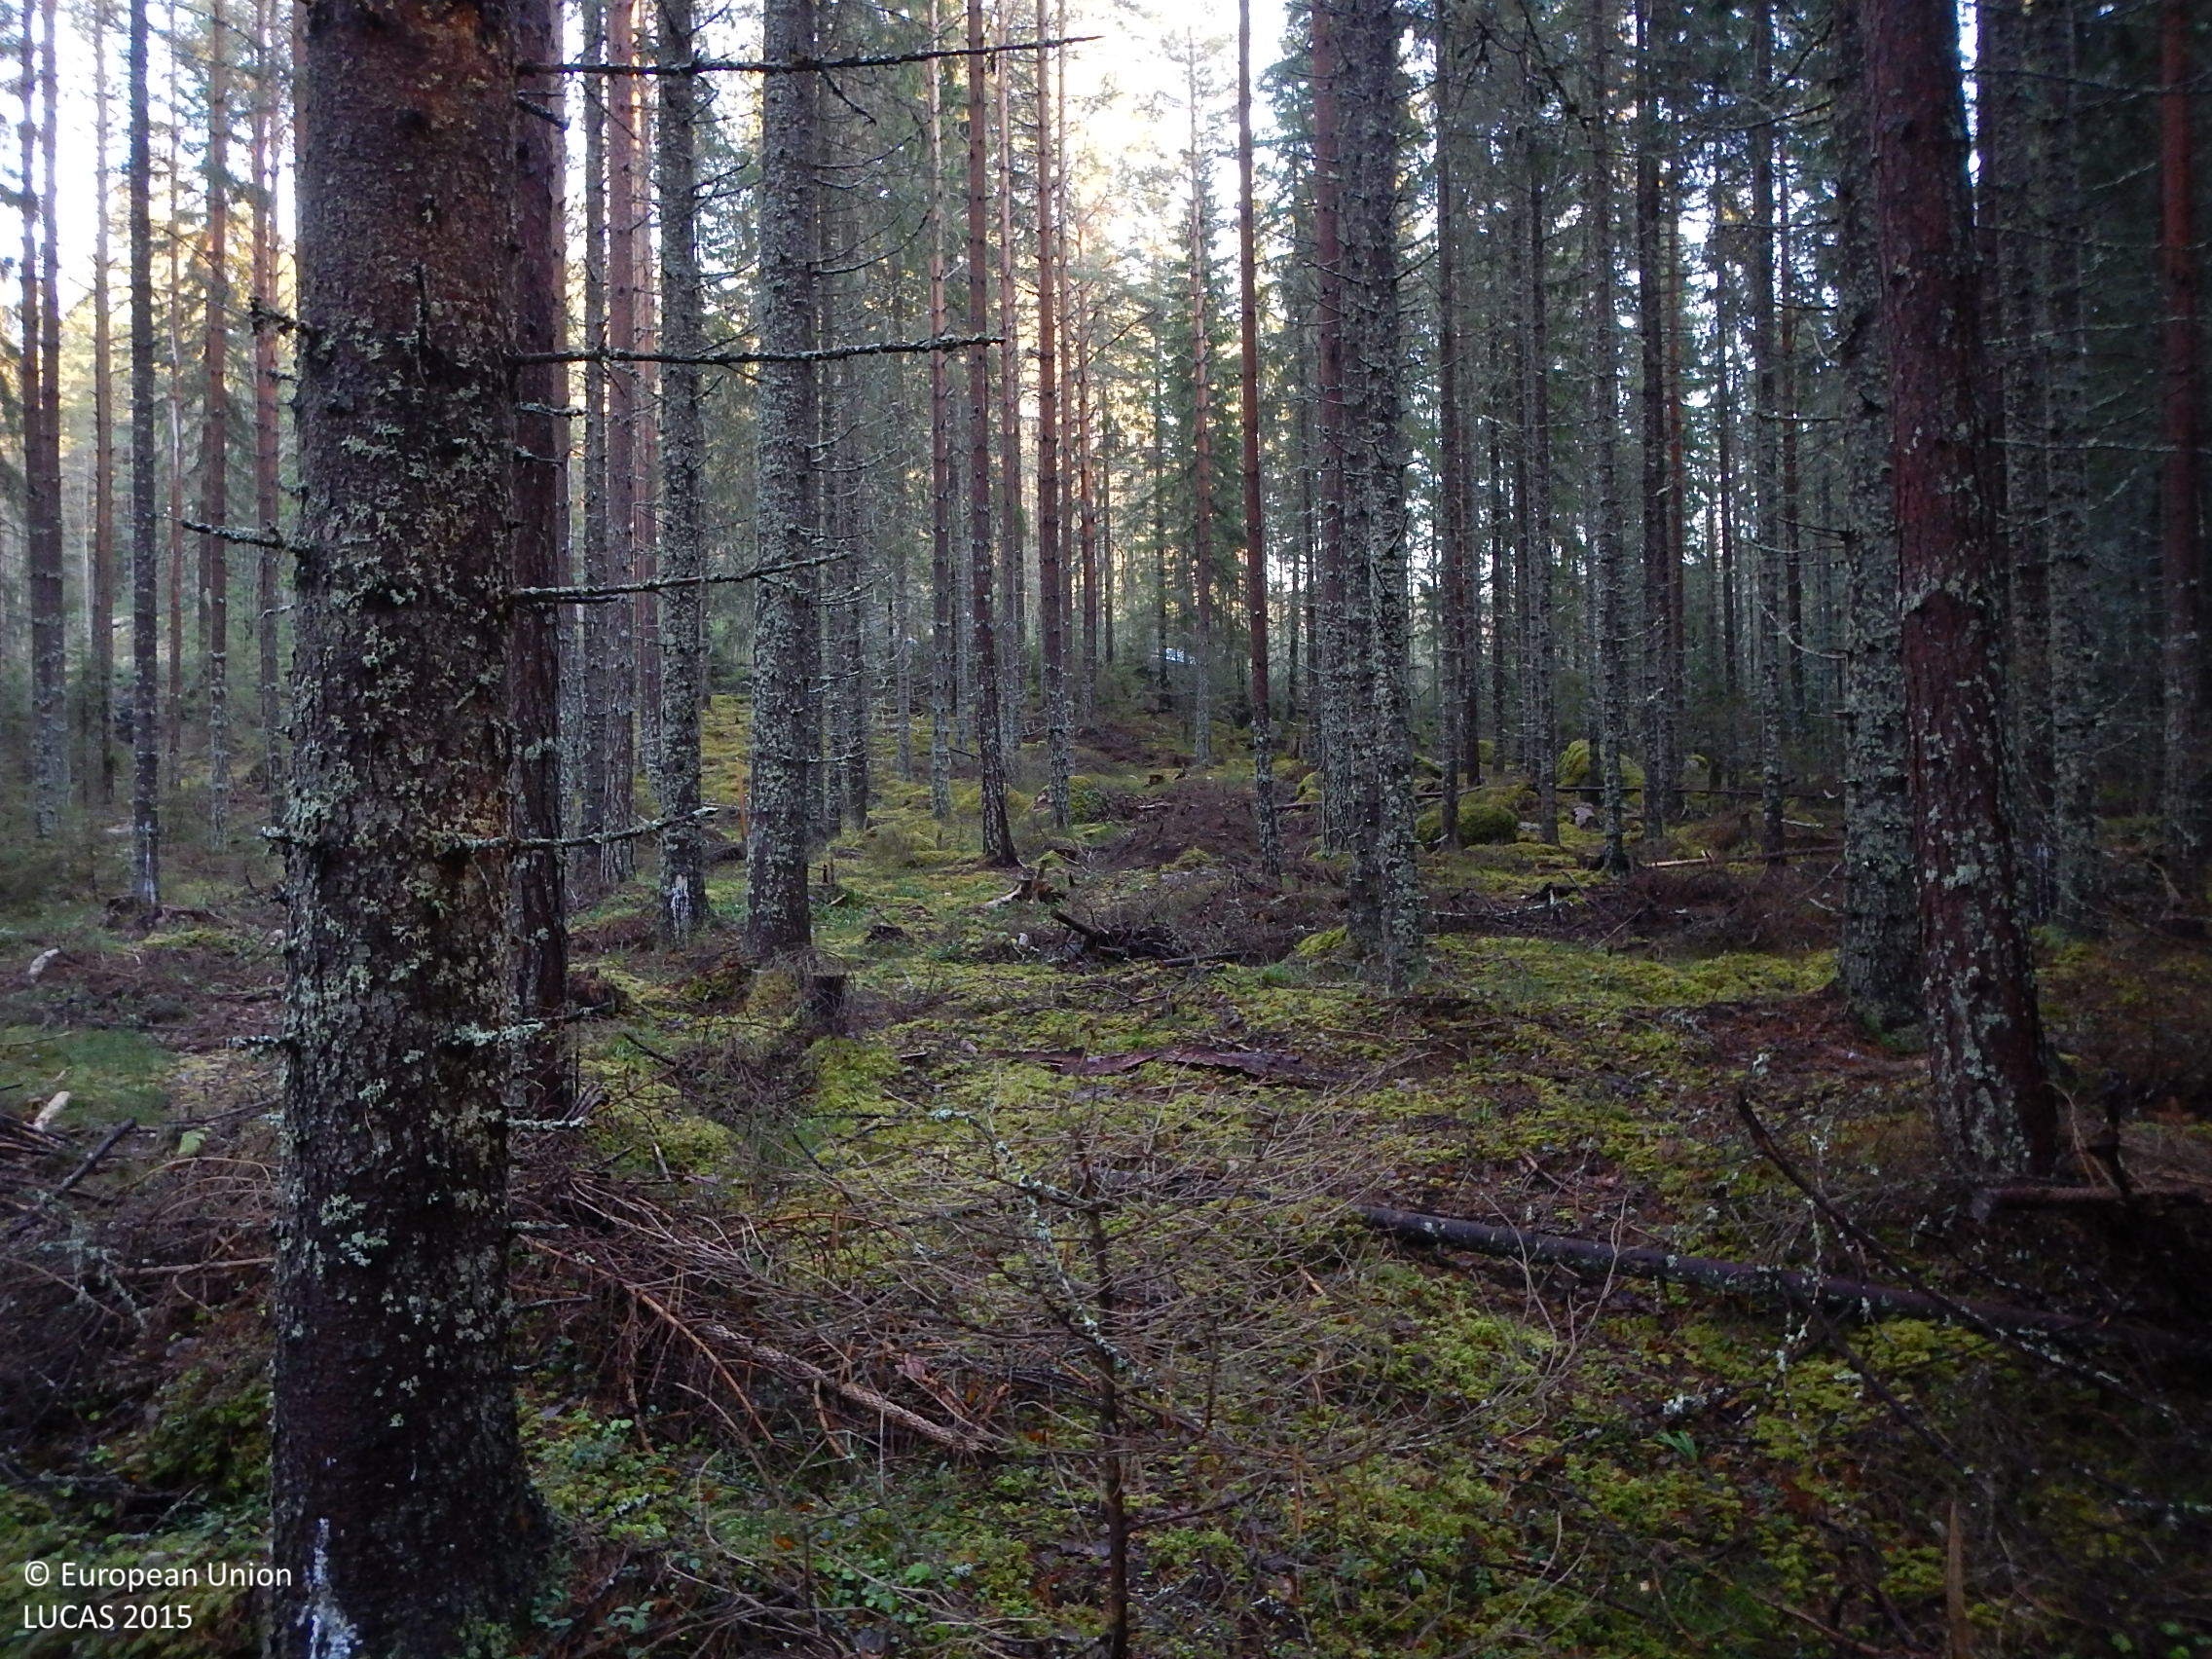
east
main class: Woodland
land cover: Spruce dominated coniferous woodland
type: boreal forest
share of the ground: > 75 %
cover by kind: coniferous forest trees 80 %, lichens and mosses 15 %, broadleaved forest trees 5 %
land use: Forestry
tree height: > 5 m
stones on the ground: < 10 %
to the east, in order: Spruce dominated coniferous woodland; Other coniferous woodland; Shruby margins; Tracks; Abandoned hedges; Ditches and canals; Pine dominated coniferous woodland; Other coniferous woodland
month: November
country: SE
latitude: 61.8813
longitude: 16.3539
